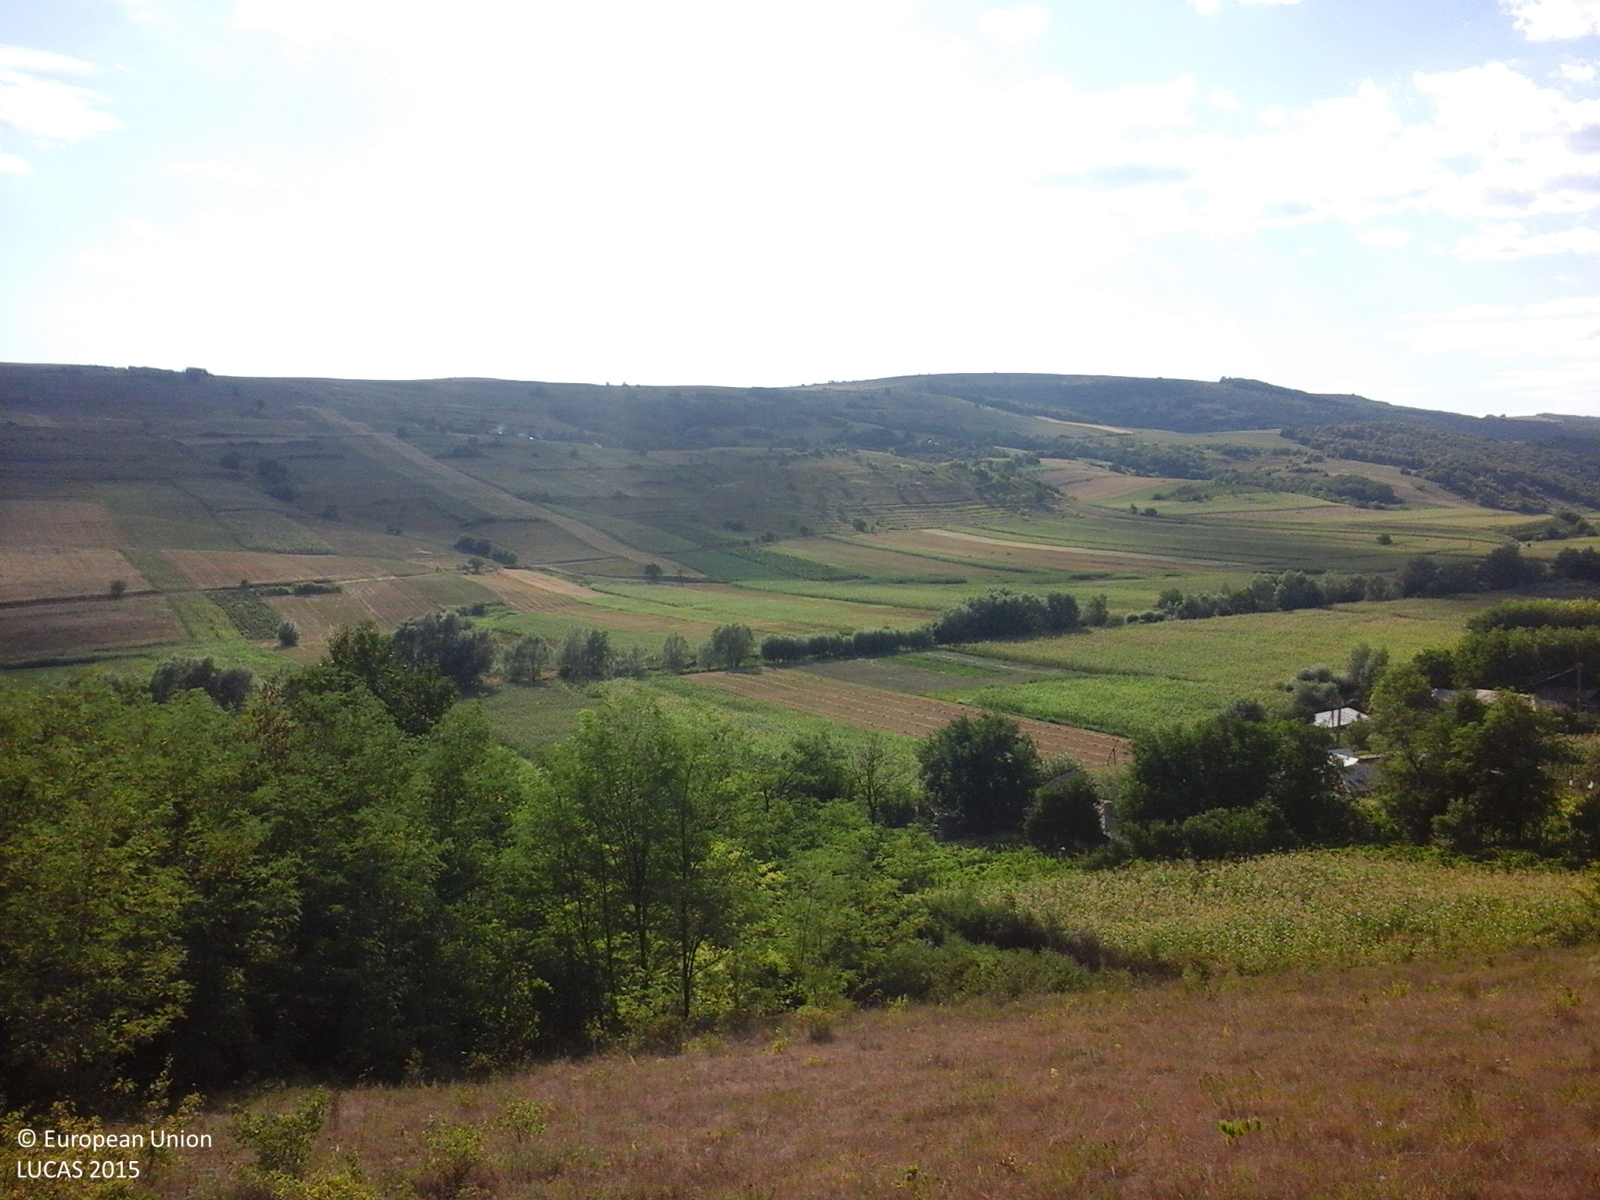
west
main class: Grassland
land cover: Grassland with sparse tree/shrub cover
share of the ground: > 75 %
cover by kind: herbaceous plants 85 %, shrubs 10 %, broadleaved forest trees 5 %
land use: Fallow land
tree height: < 5 m
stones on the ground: < 10 %
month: July
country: RO
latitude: 46.3333
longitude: 27.3700
